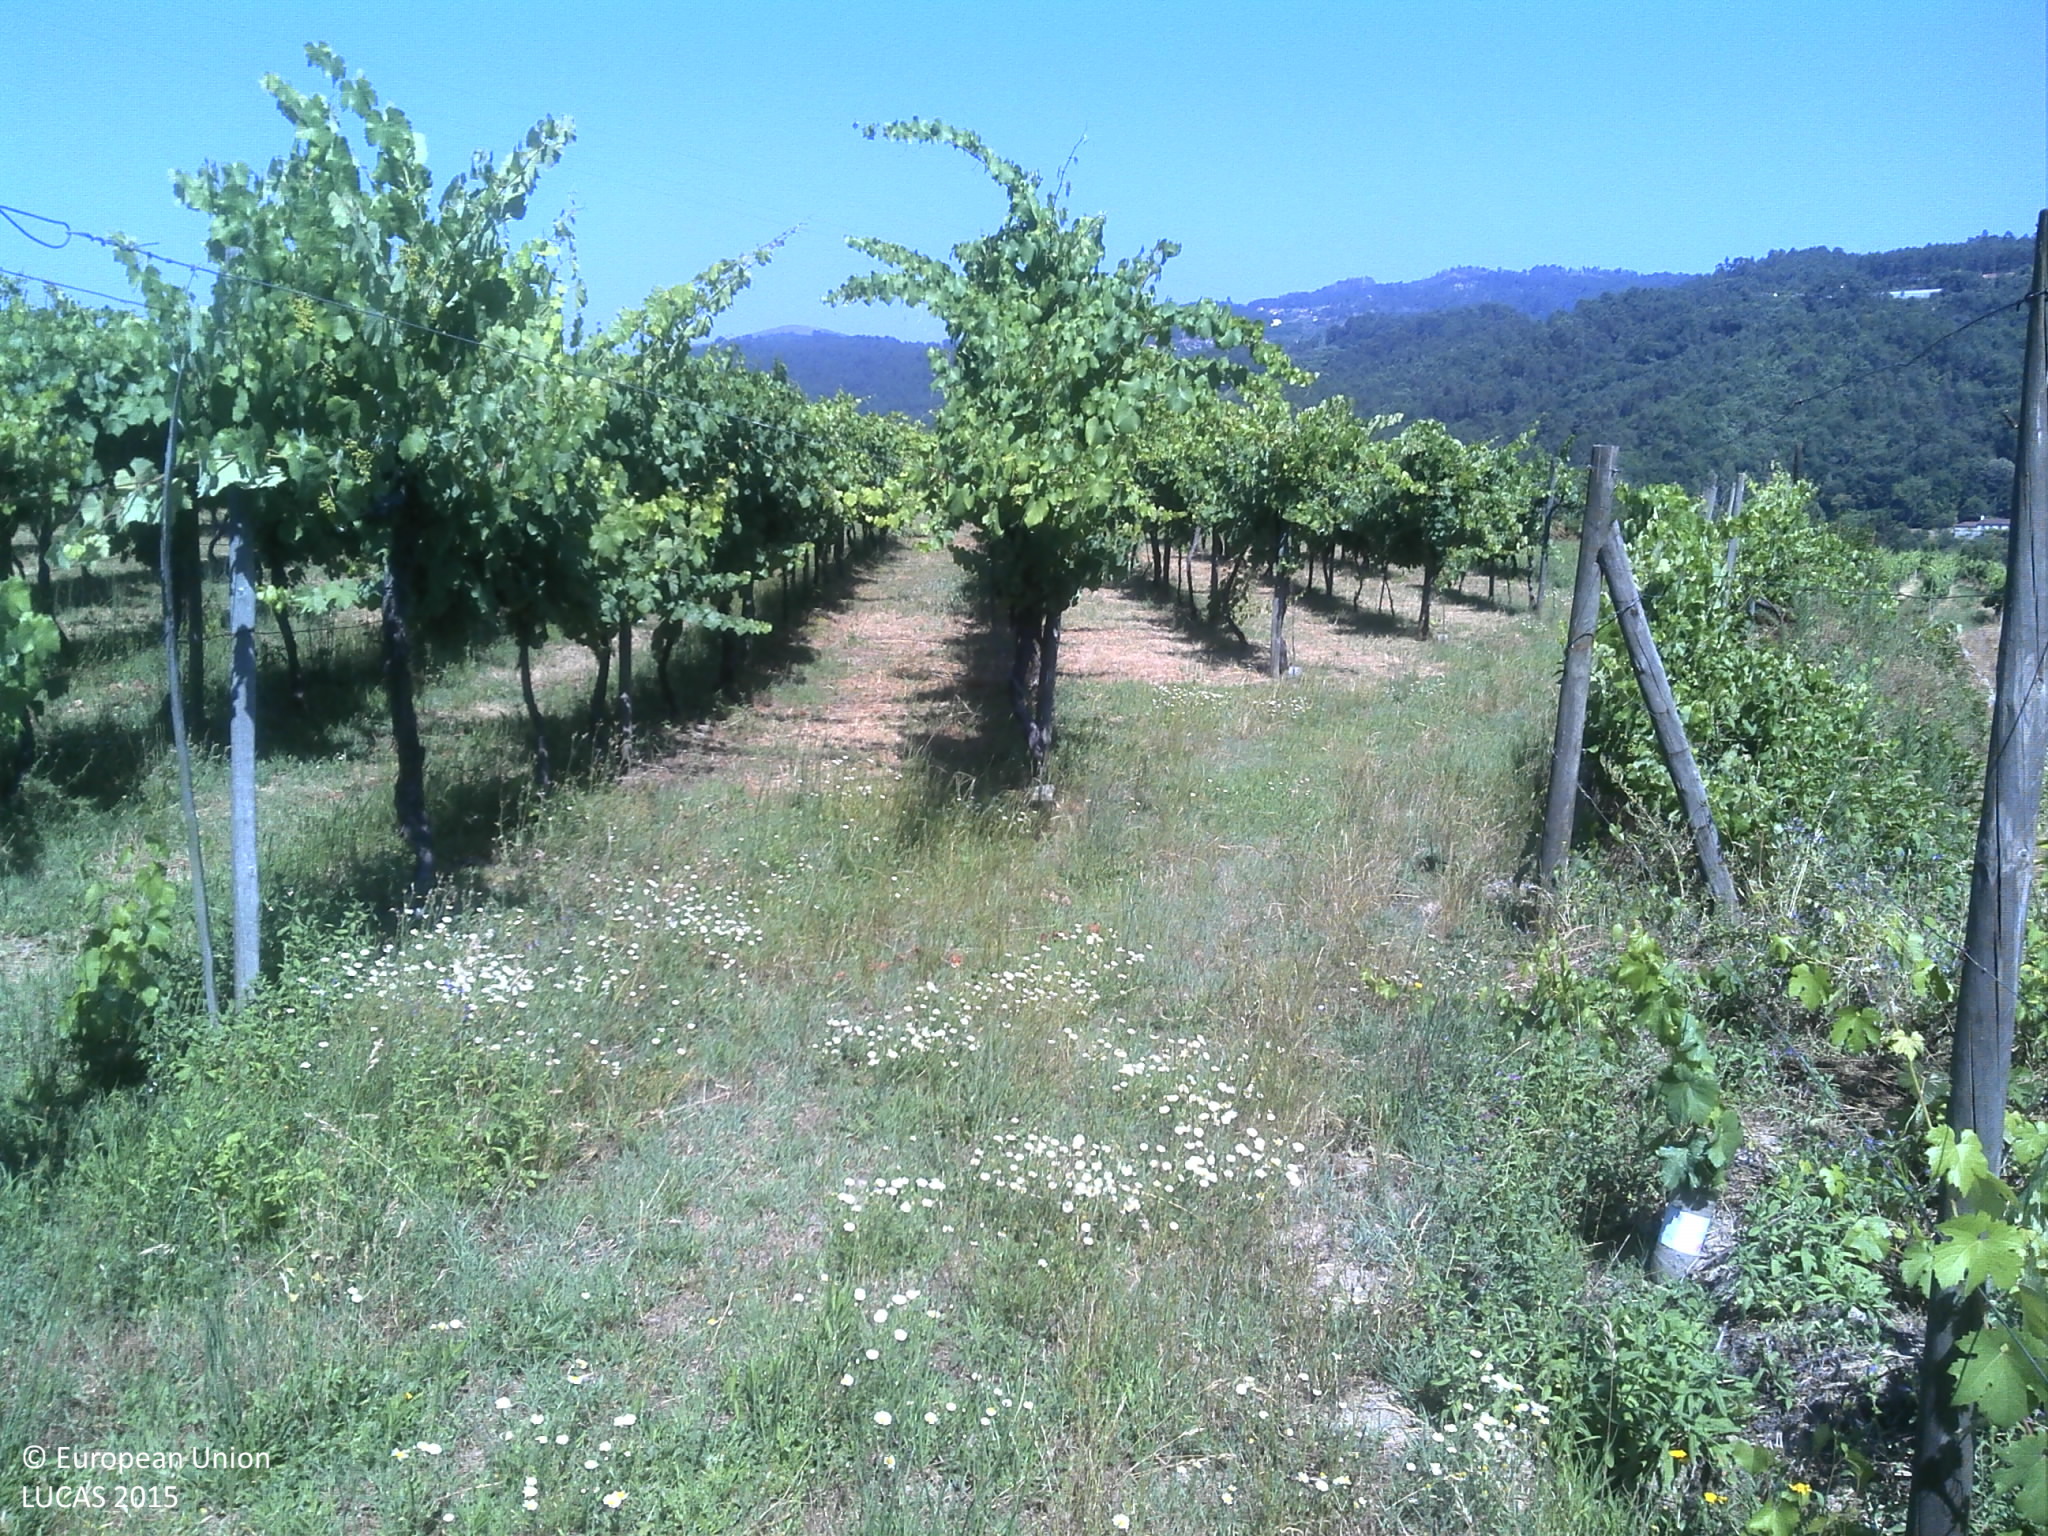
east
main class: Cropland
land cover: Vineyards
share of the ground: 10 - 25 %
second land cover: Grassland without tree/shrub cover
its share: 25 - 50 %
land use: Agriculture (excluding fallow land and kitchen gardens)
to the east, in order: Vineyards; Grassland without tree/shrub cover; Vineyards; Tracks; Vineyards; Artificial constructions in urban areas; Shrubland without tree cover; Vineyards
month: June
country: PT
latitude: 41.2910
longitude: -8.0628
